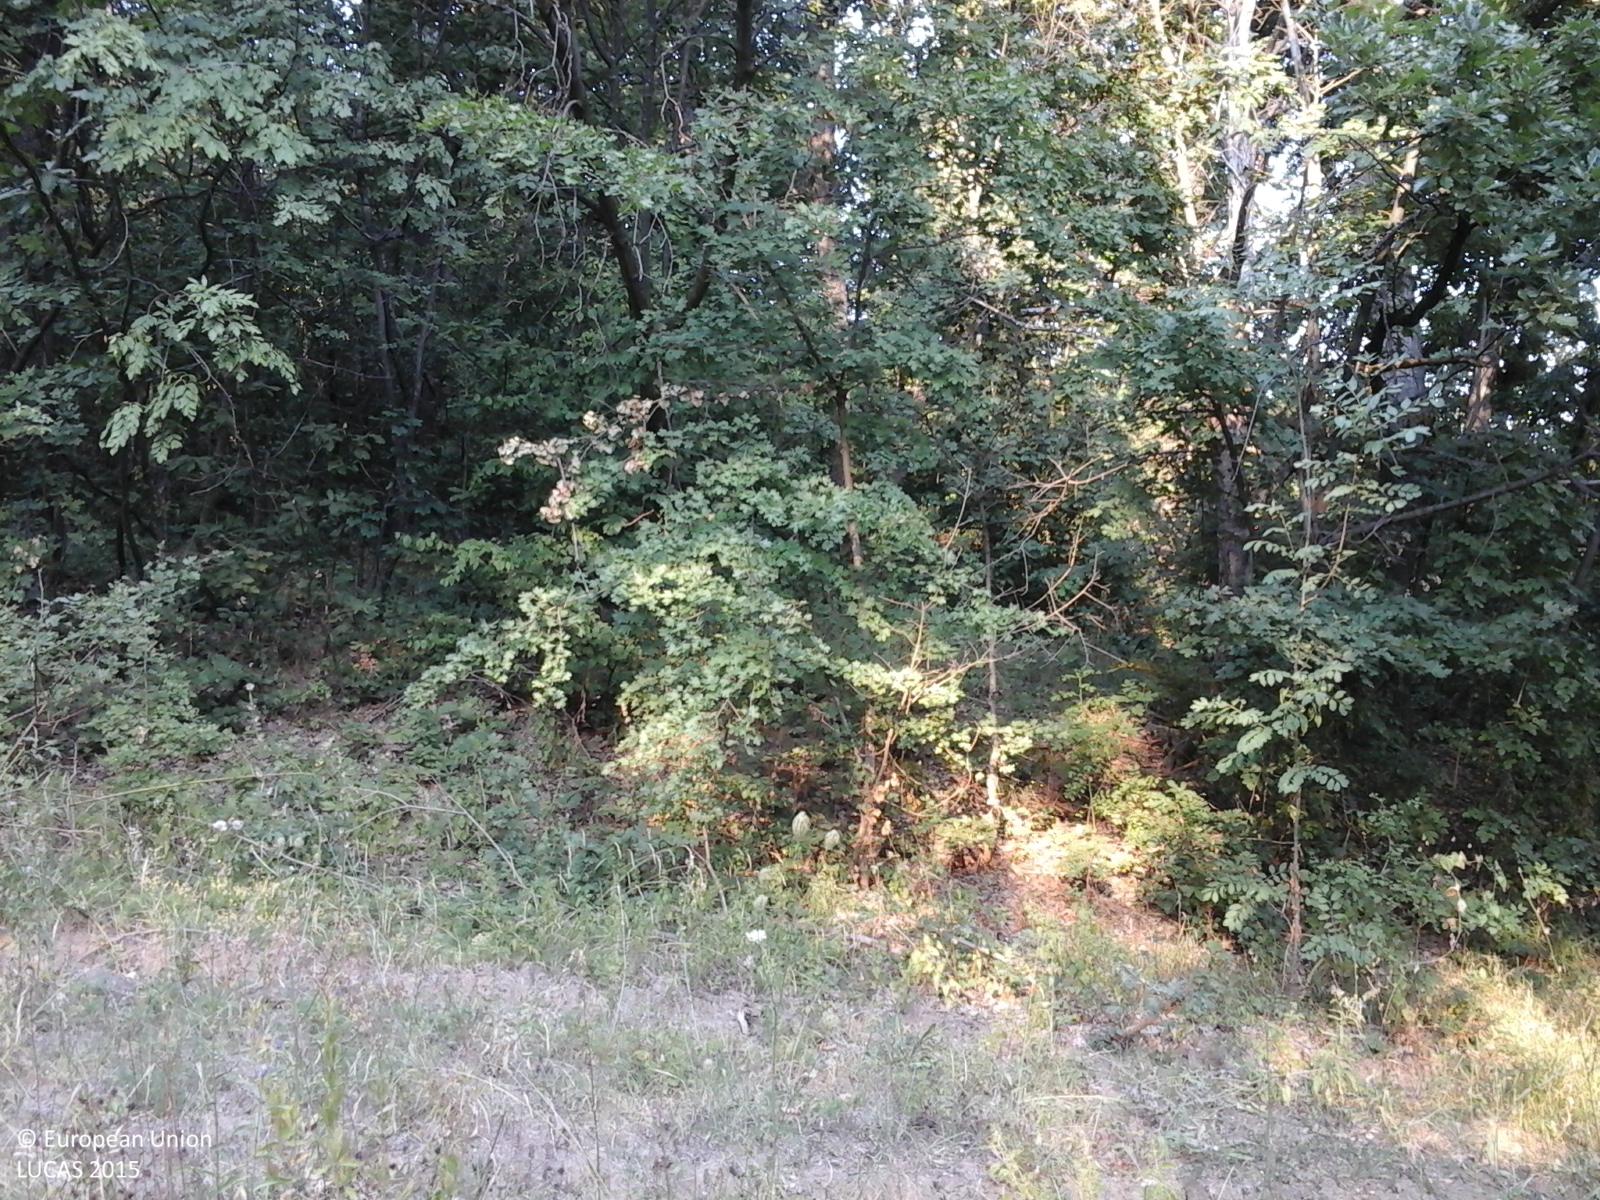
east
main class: Woodland
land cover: Broadleaved woodland
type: acidophilous oak and oak-birch forest
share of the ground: > 75 %
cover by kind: broadleaved forest trees 100 %
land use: Forestry
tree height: > 5 m
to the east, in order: Broadleaved woodland; Tracks; Broadleaved woodland; Grassland with sparse tree/shrub cover; Tracks; Broadleaved woodland
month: August
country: RO
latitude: 44.5788
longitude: 23.2100
